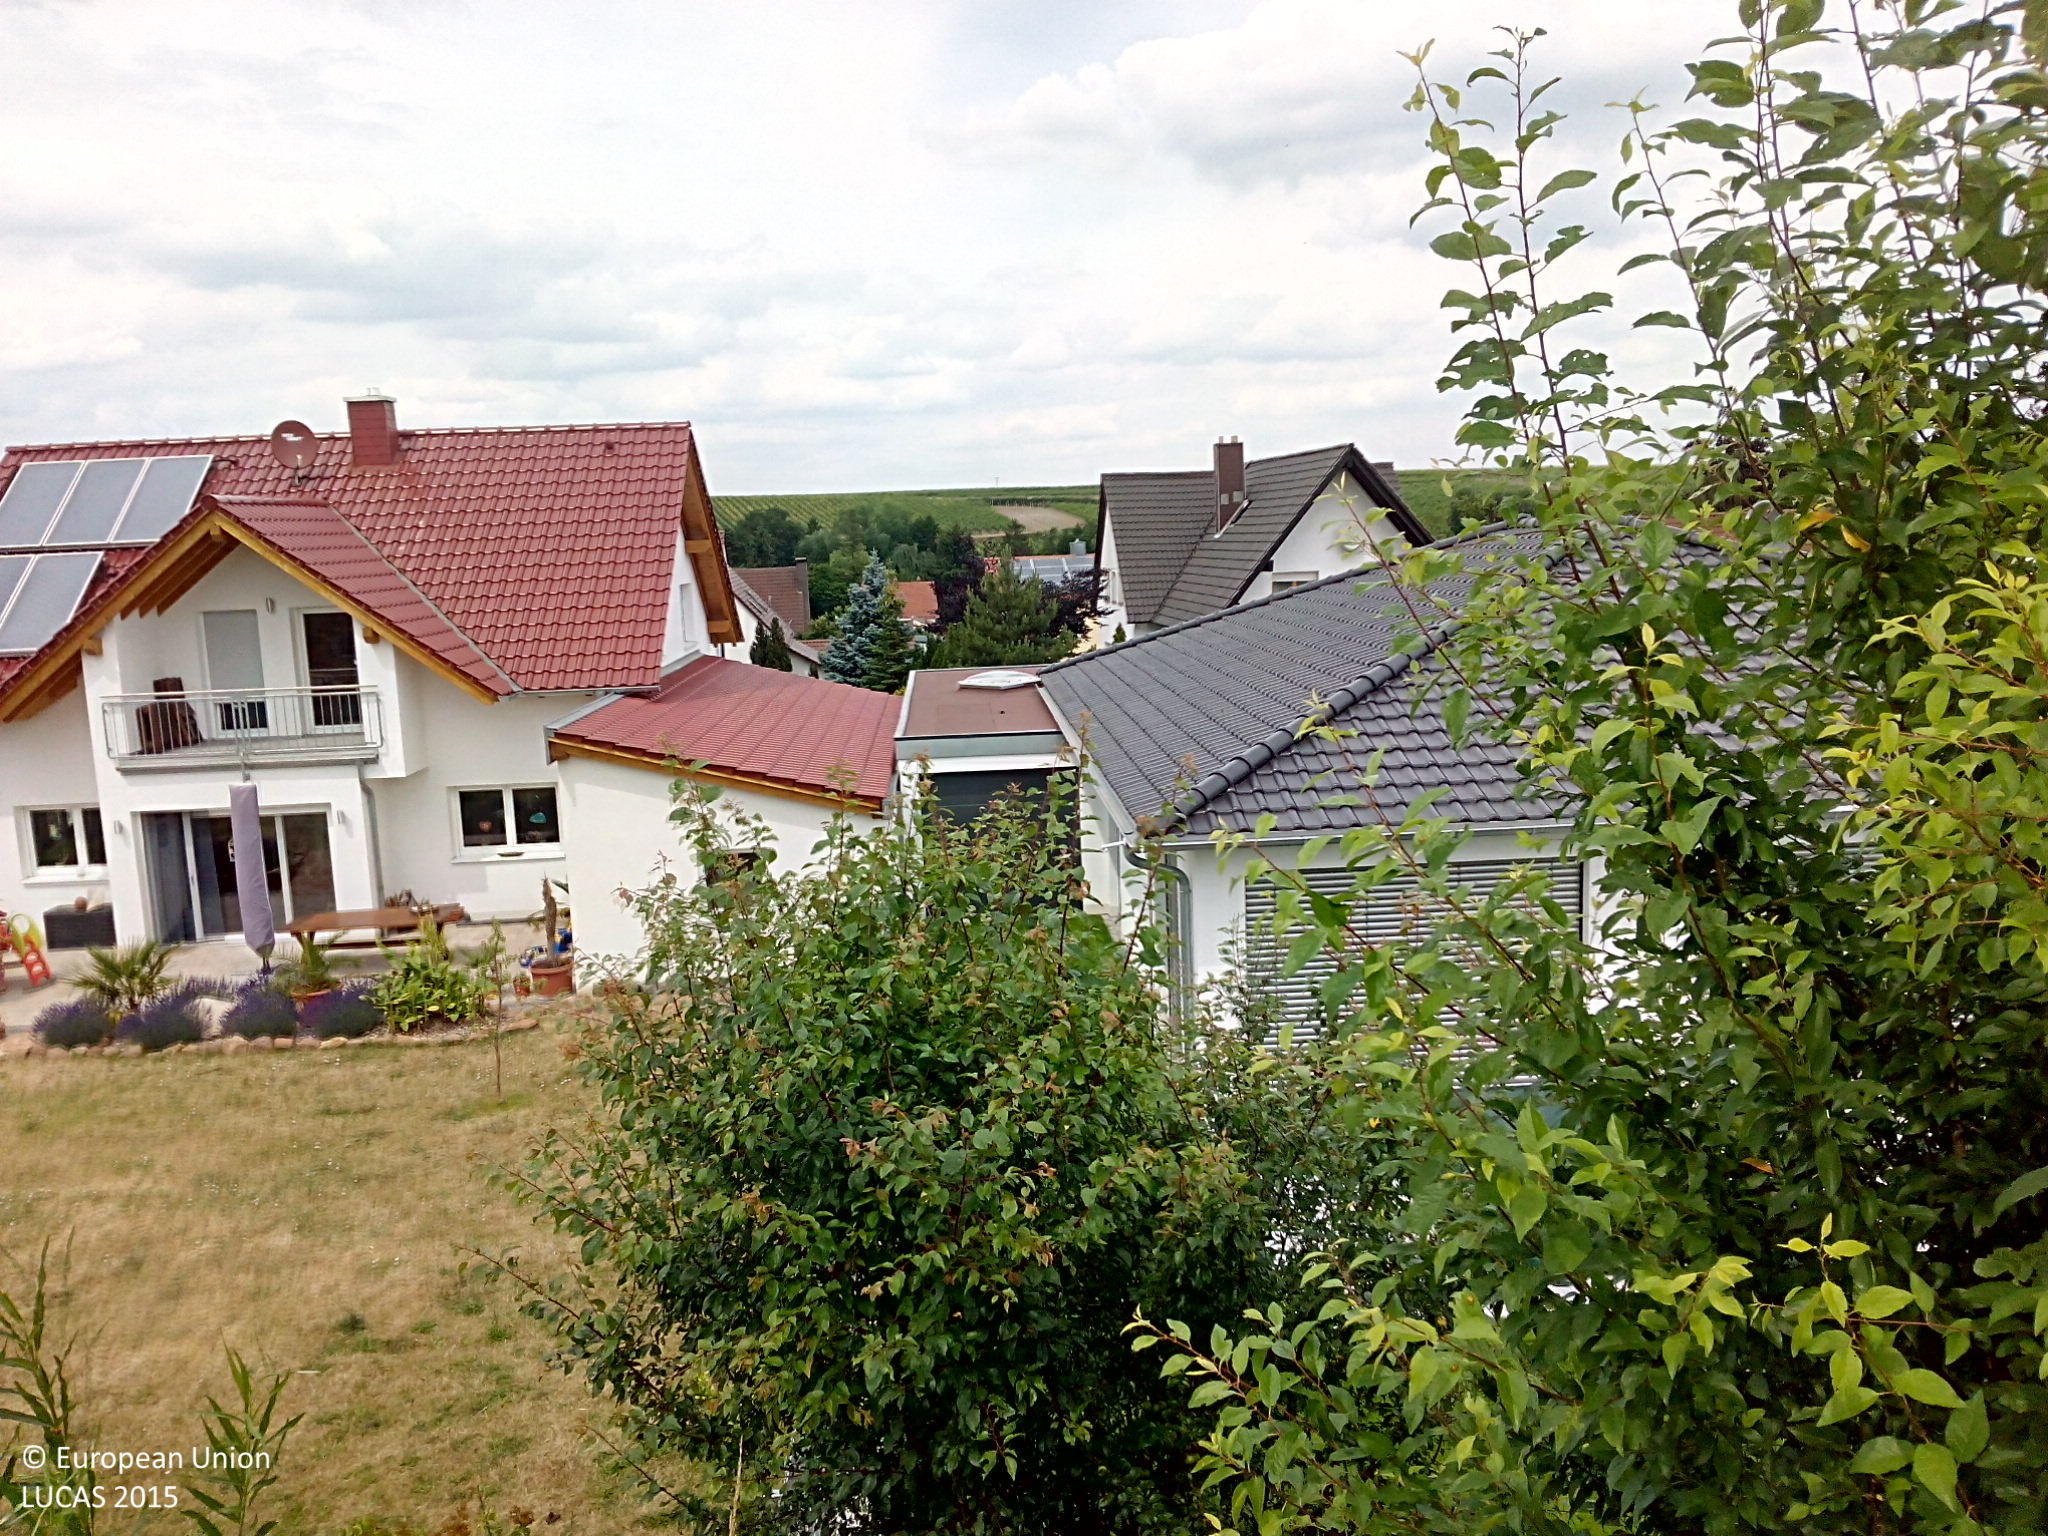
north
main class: Grassland
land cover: Grassland with sparse tree/shrub cover
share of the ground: > 75 %
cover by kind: herbaceous plants 65 %, unconsolidated bare surface 25 %, broadleaved forest trees 5 %, shrubs 5 %
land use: Residential
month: June
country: DE
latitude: 49.5399
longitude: 8.1625
